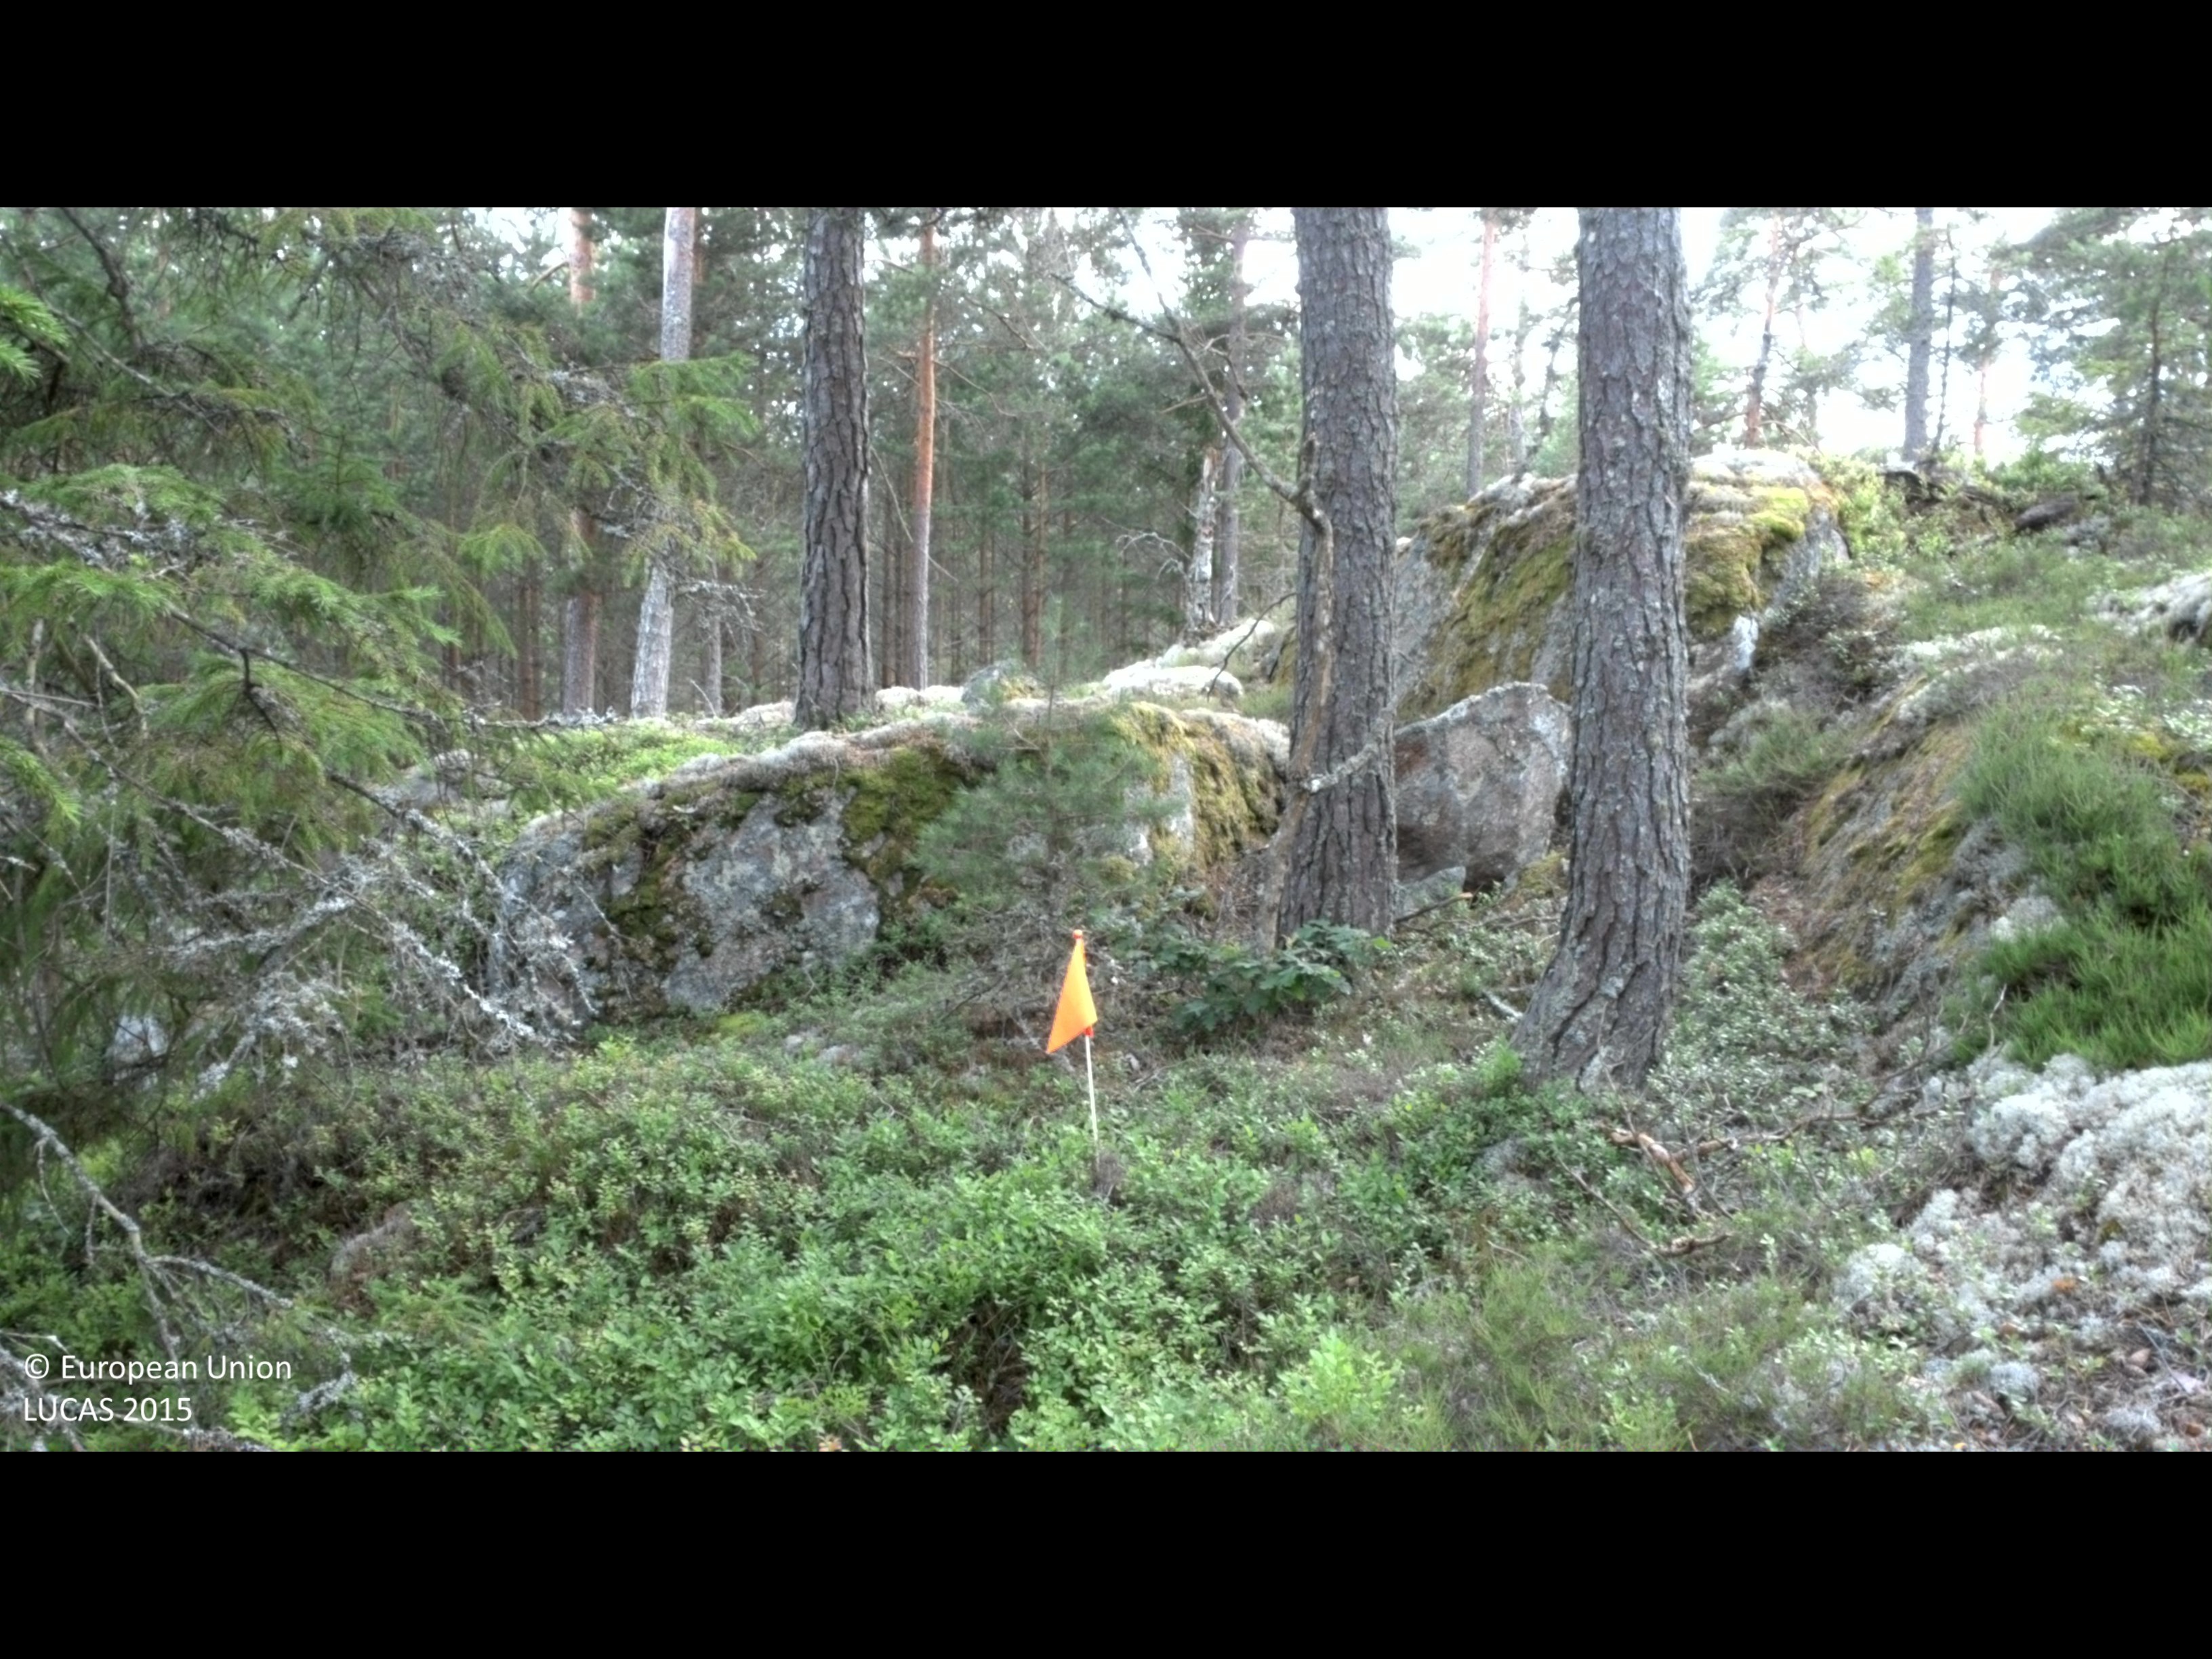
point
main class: Woodland
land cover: Pine dominated coniferous woodland
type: boreal forest
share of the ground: 50 - 75 %
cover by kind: coniferous forest trees 65 %, shrubs 20 %, lichens and mosses 15 %
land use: Forestry
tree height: > 5 m
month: July
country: SE
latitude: 58.4041
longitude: 16.1390
